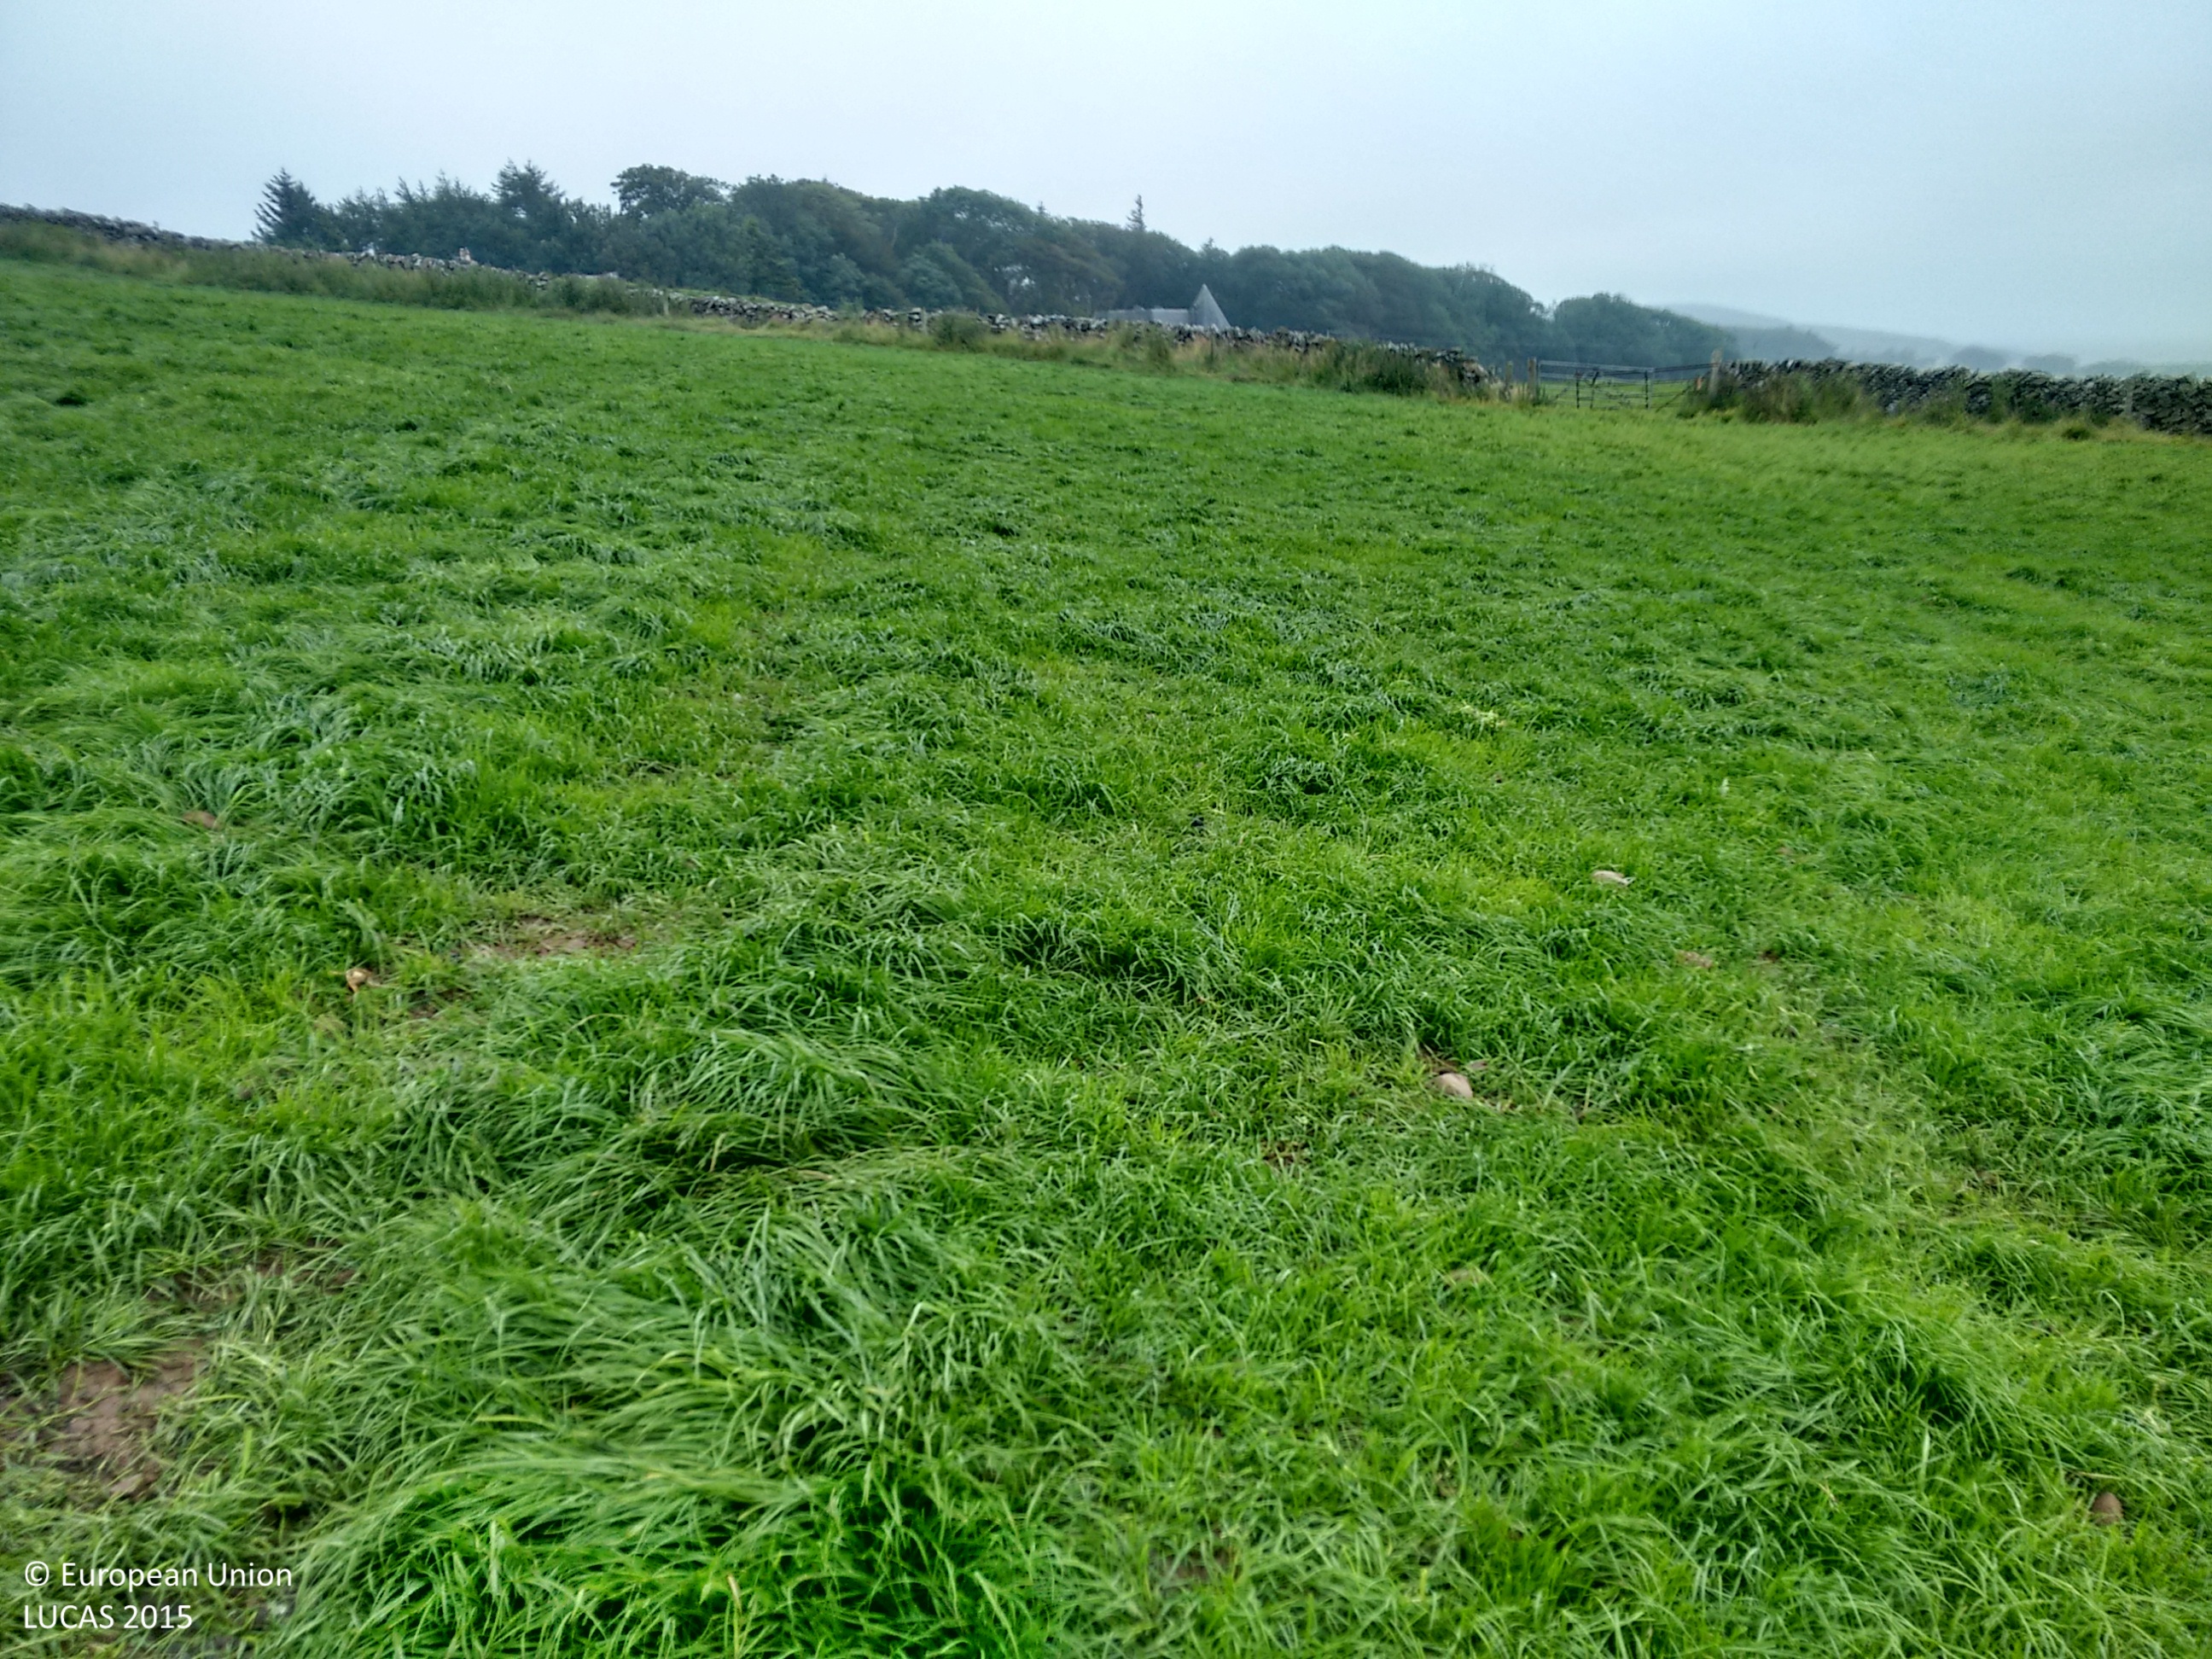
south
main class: Grassland
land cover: Grassland without tree/shrub cover
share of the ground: > 75 %
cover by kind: herbaceous plants 100 %
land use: Agriculture (excluding fallow land and kitchen gardens)
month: July
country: GB
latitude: 54.7994
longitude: -4.1091
